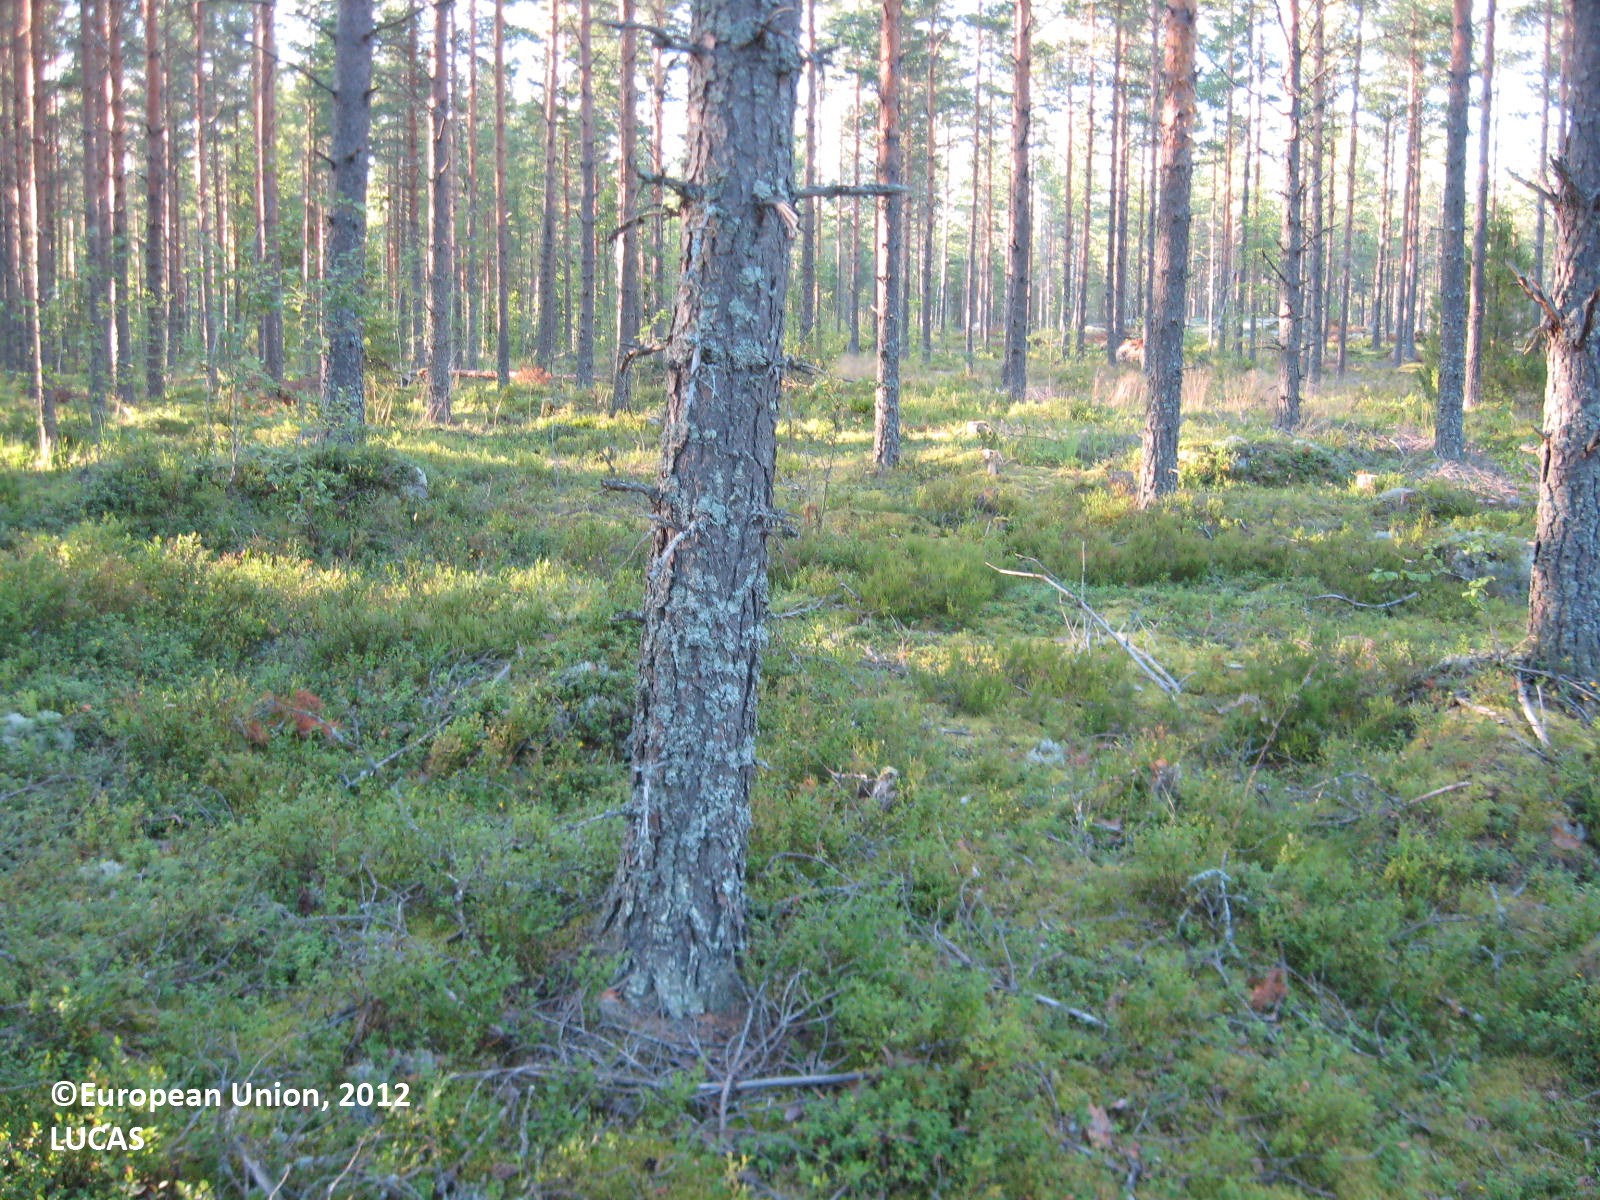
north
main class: Woodland
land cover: Pine dominated coniferous woodland
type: boreal forest
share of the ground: > 75 %
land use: Forestry
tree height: > 5 m
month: July
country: FI
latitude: 61.9435
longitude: 22.2735
